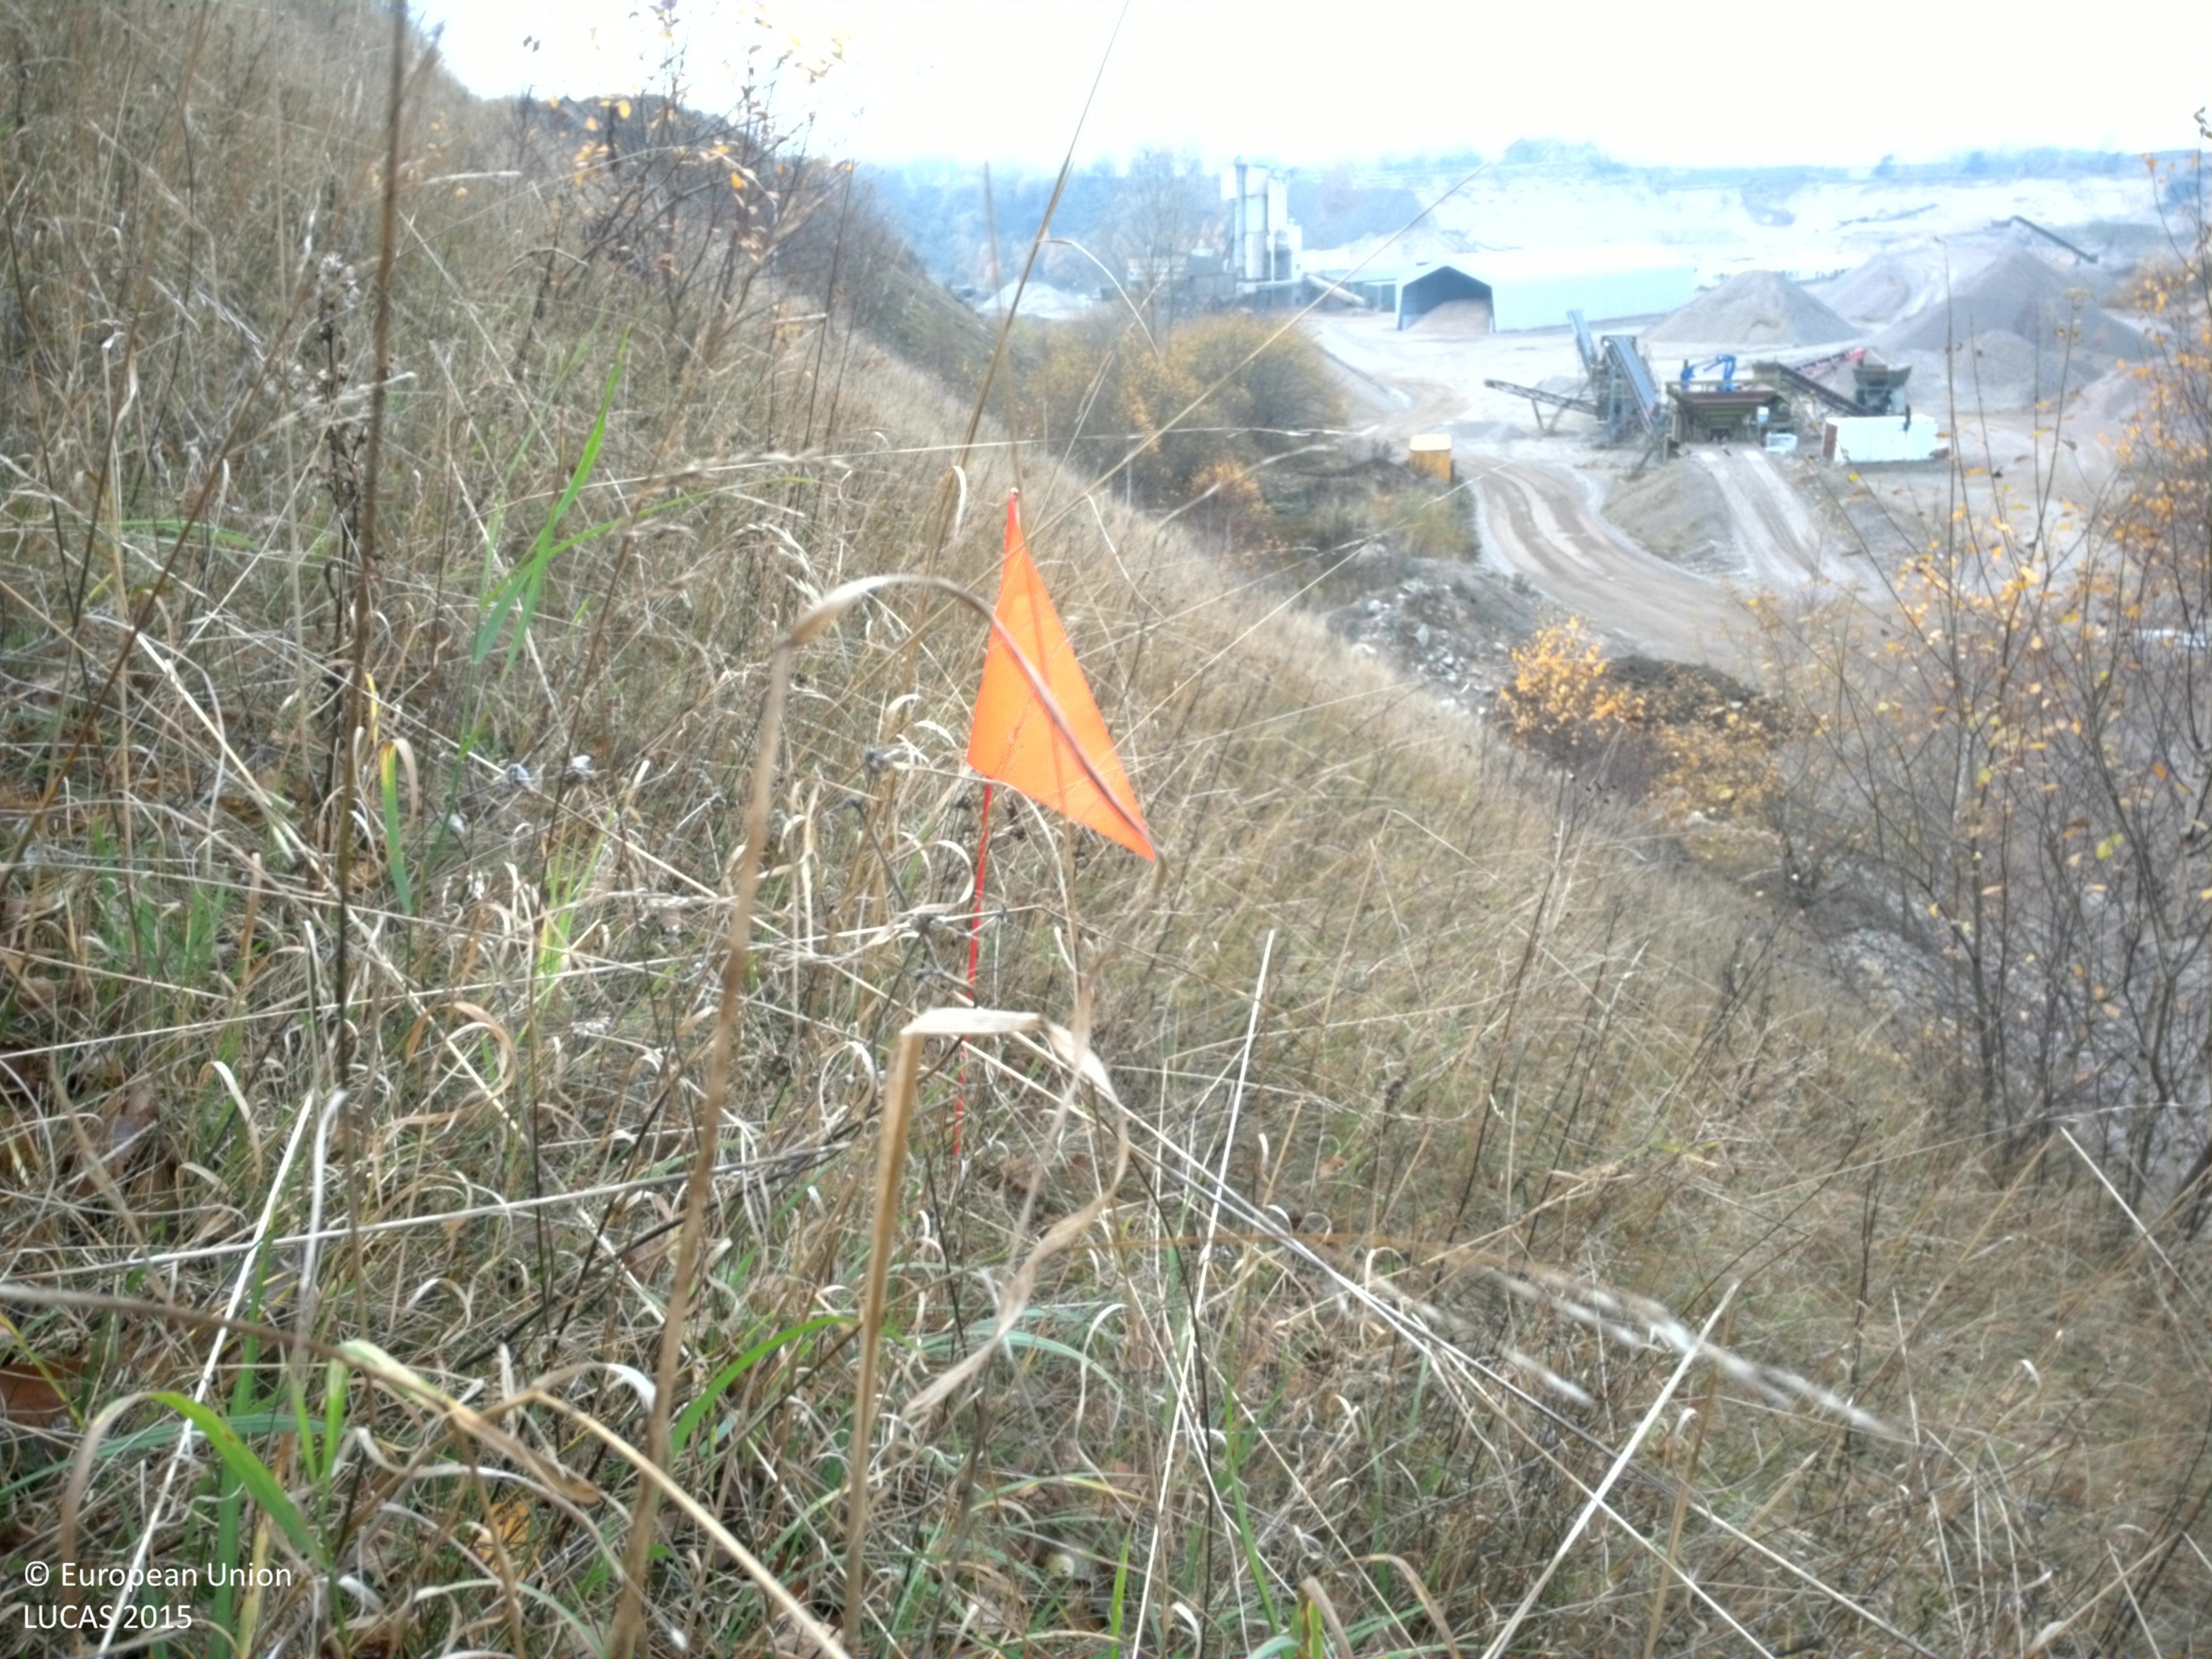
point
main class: Woodland
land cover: Broadleaved woodland
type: hemiboreal forest and nemoral coniferous forest and mixed broadleaved-coniferous forest
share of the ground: 10 - 25 %
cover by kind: herbaceous plants 80 %, broadleaved forest trees 20 %
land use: Mining and quarrying
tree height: < 5 m
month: November
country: SE
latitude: 56.1151
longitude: 13.0693
